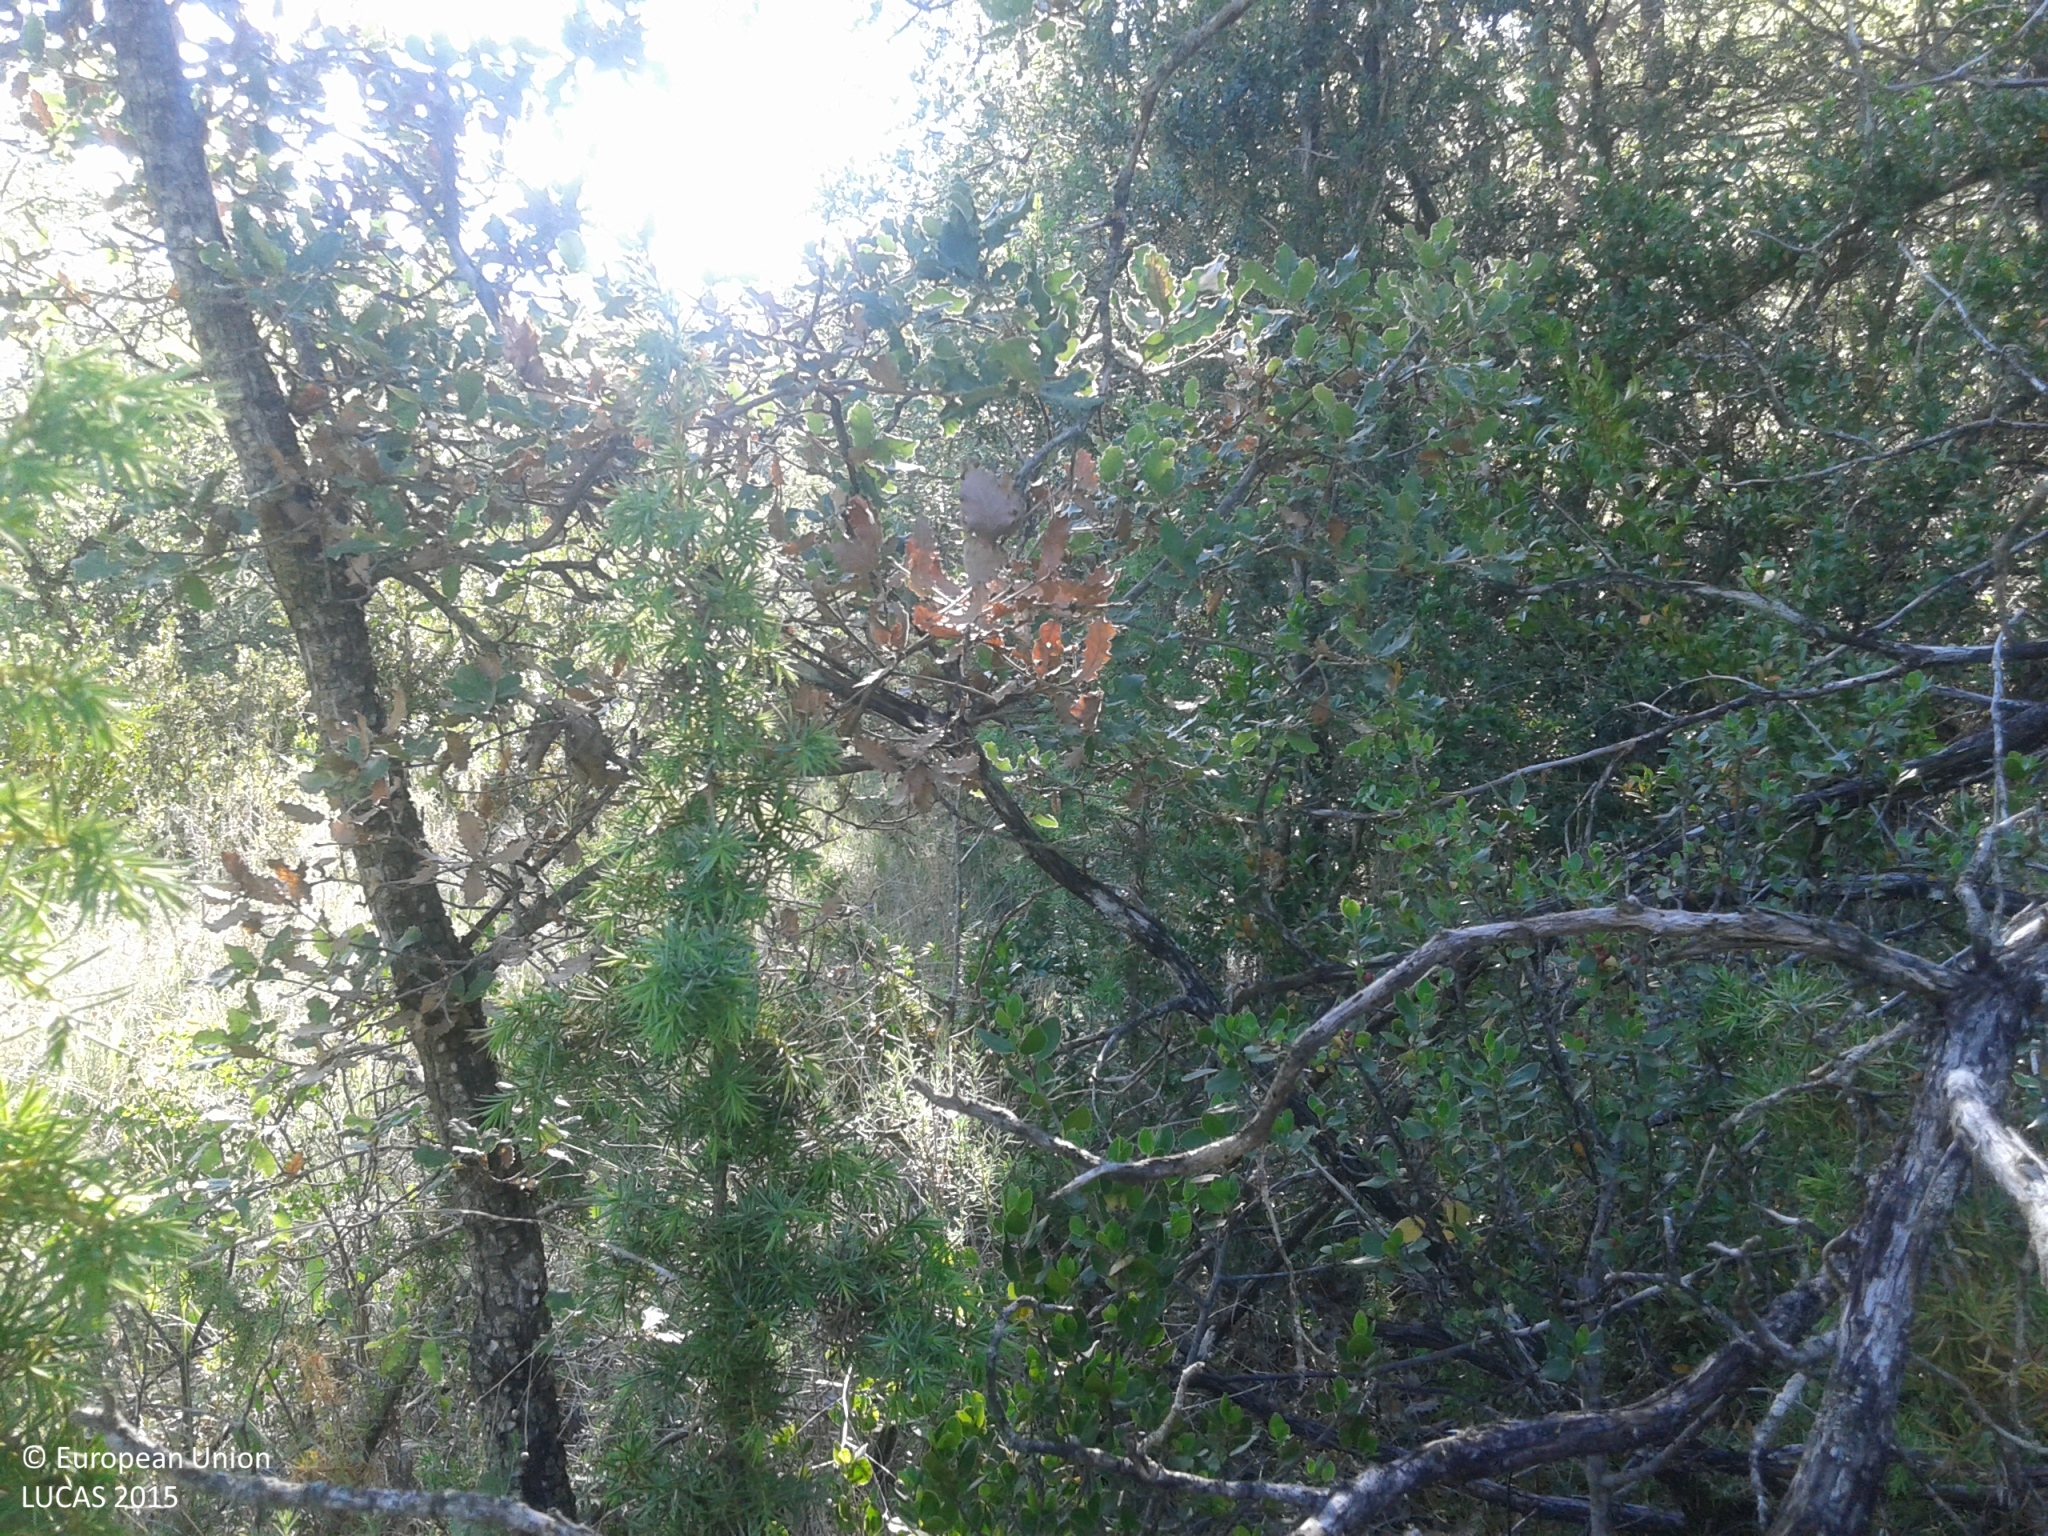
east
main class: Woodland
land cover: Broadleaved woodland
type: thermophilous deciduous forest
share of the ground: > 75 %
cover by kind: broadleaved forest trees 70 %, shrubs 15 %, coniferous forest trees 10 %, herbaceous plants 5 %
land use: Semi-natural and natural areas not in use
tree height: > 5 m
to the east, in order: Broadleaved woodland; Tracks; Broadleaved woodland; Tracks; Broadleaved woodland
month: May
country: ES
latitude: 41.9008
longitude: 1.1279
